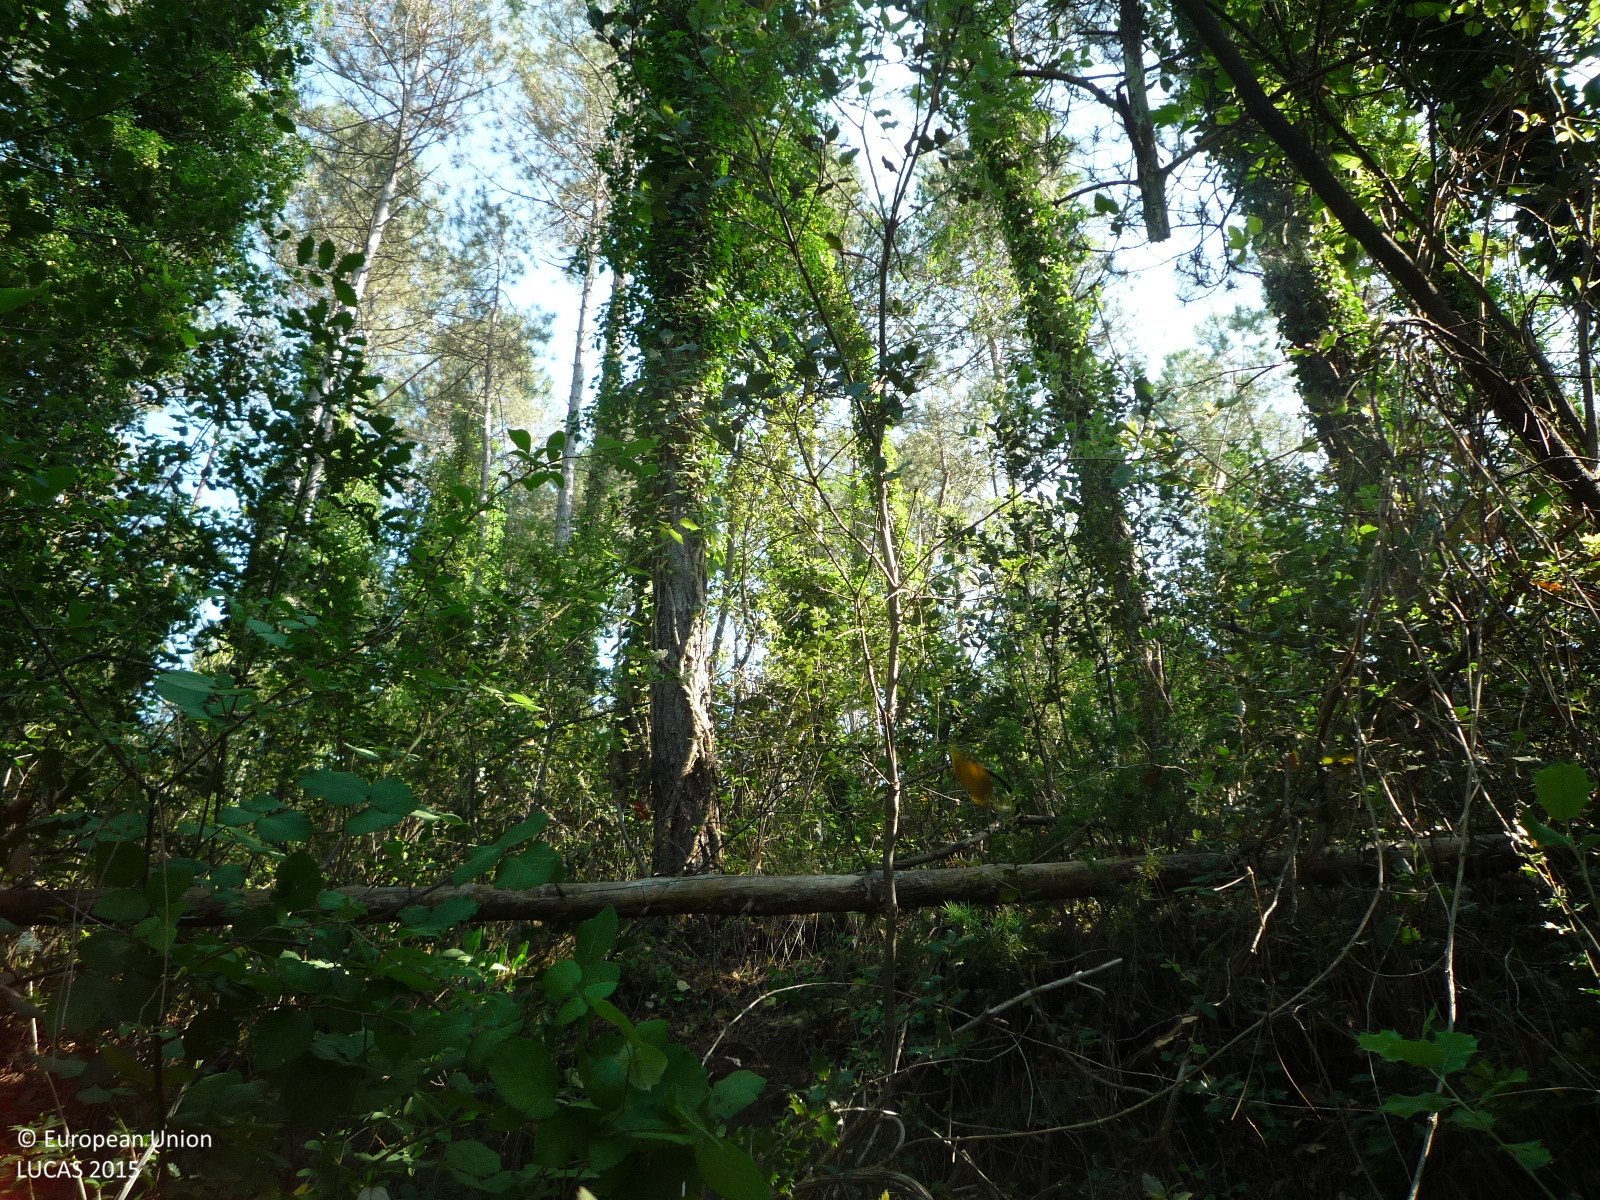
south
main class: Woodland
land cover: Pine dominated mixed woodland
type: coniferous forest of the mediterranean region
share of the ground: > 75 %
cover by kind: coniferous forest trees 70 %, broadleaved forest trees 30 %
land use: Semi-natural and natural areas not in use
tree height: > 5 m
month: May
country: ES
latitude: 41.9016
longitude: 1.9984
